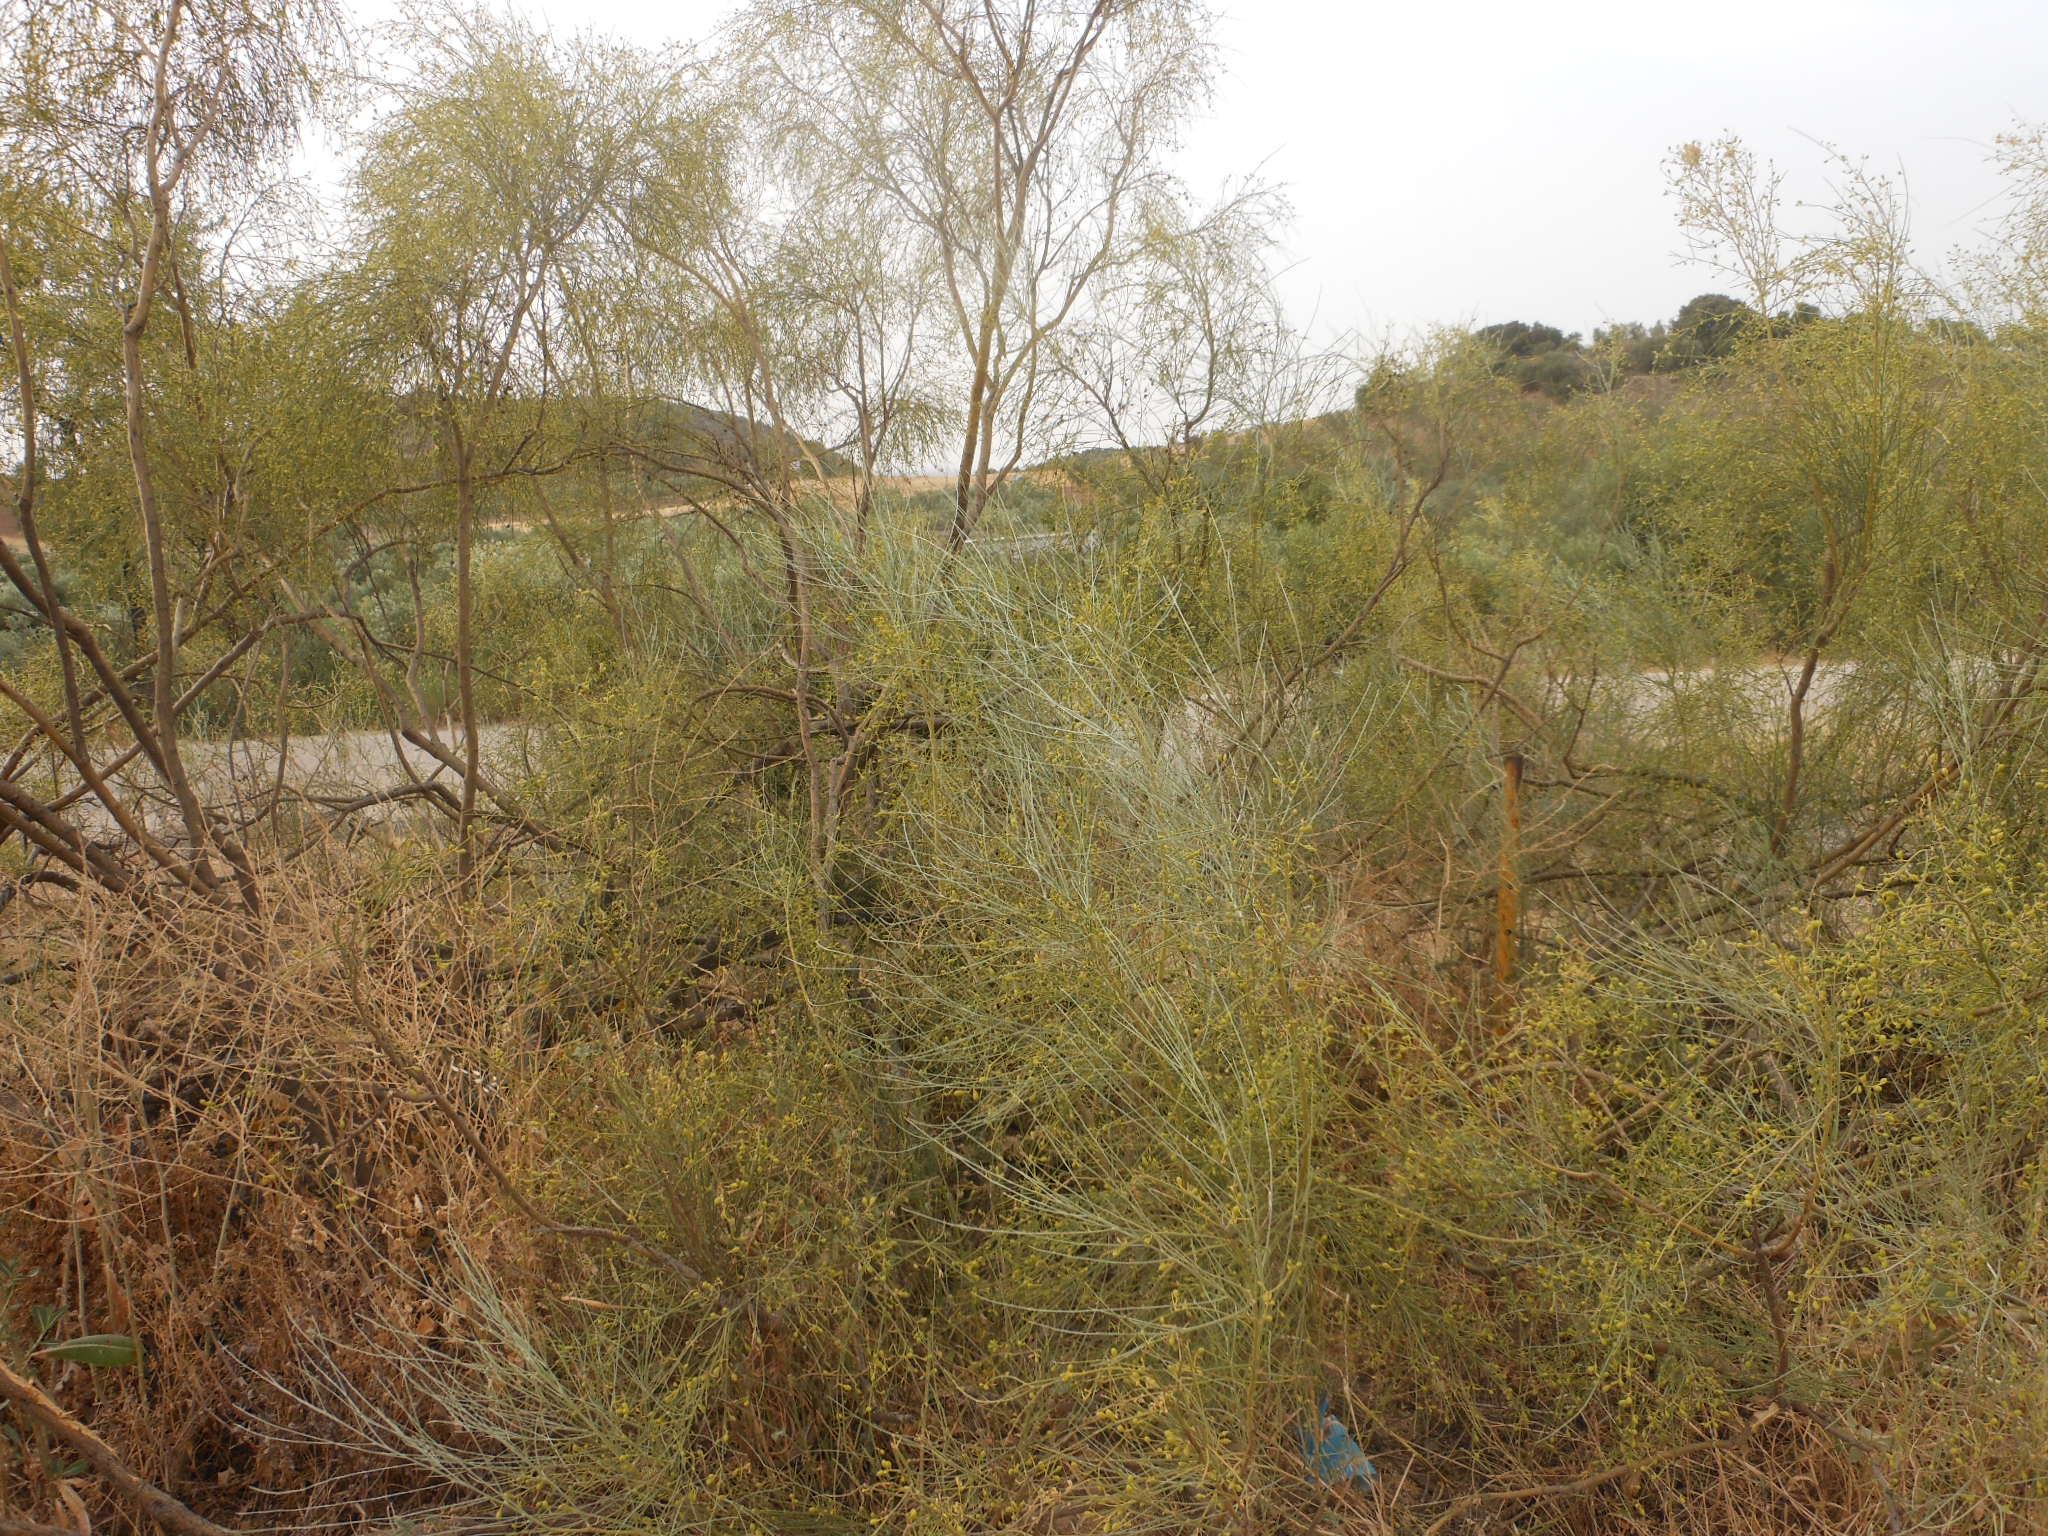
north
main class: Cropland
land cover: Oats
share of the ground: < 10 %
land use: Agriculture (excluding fallow land and kitchen gardens)
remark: Harvested field
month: June
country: ES
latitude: 37.1265
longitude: -5.4189
